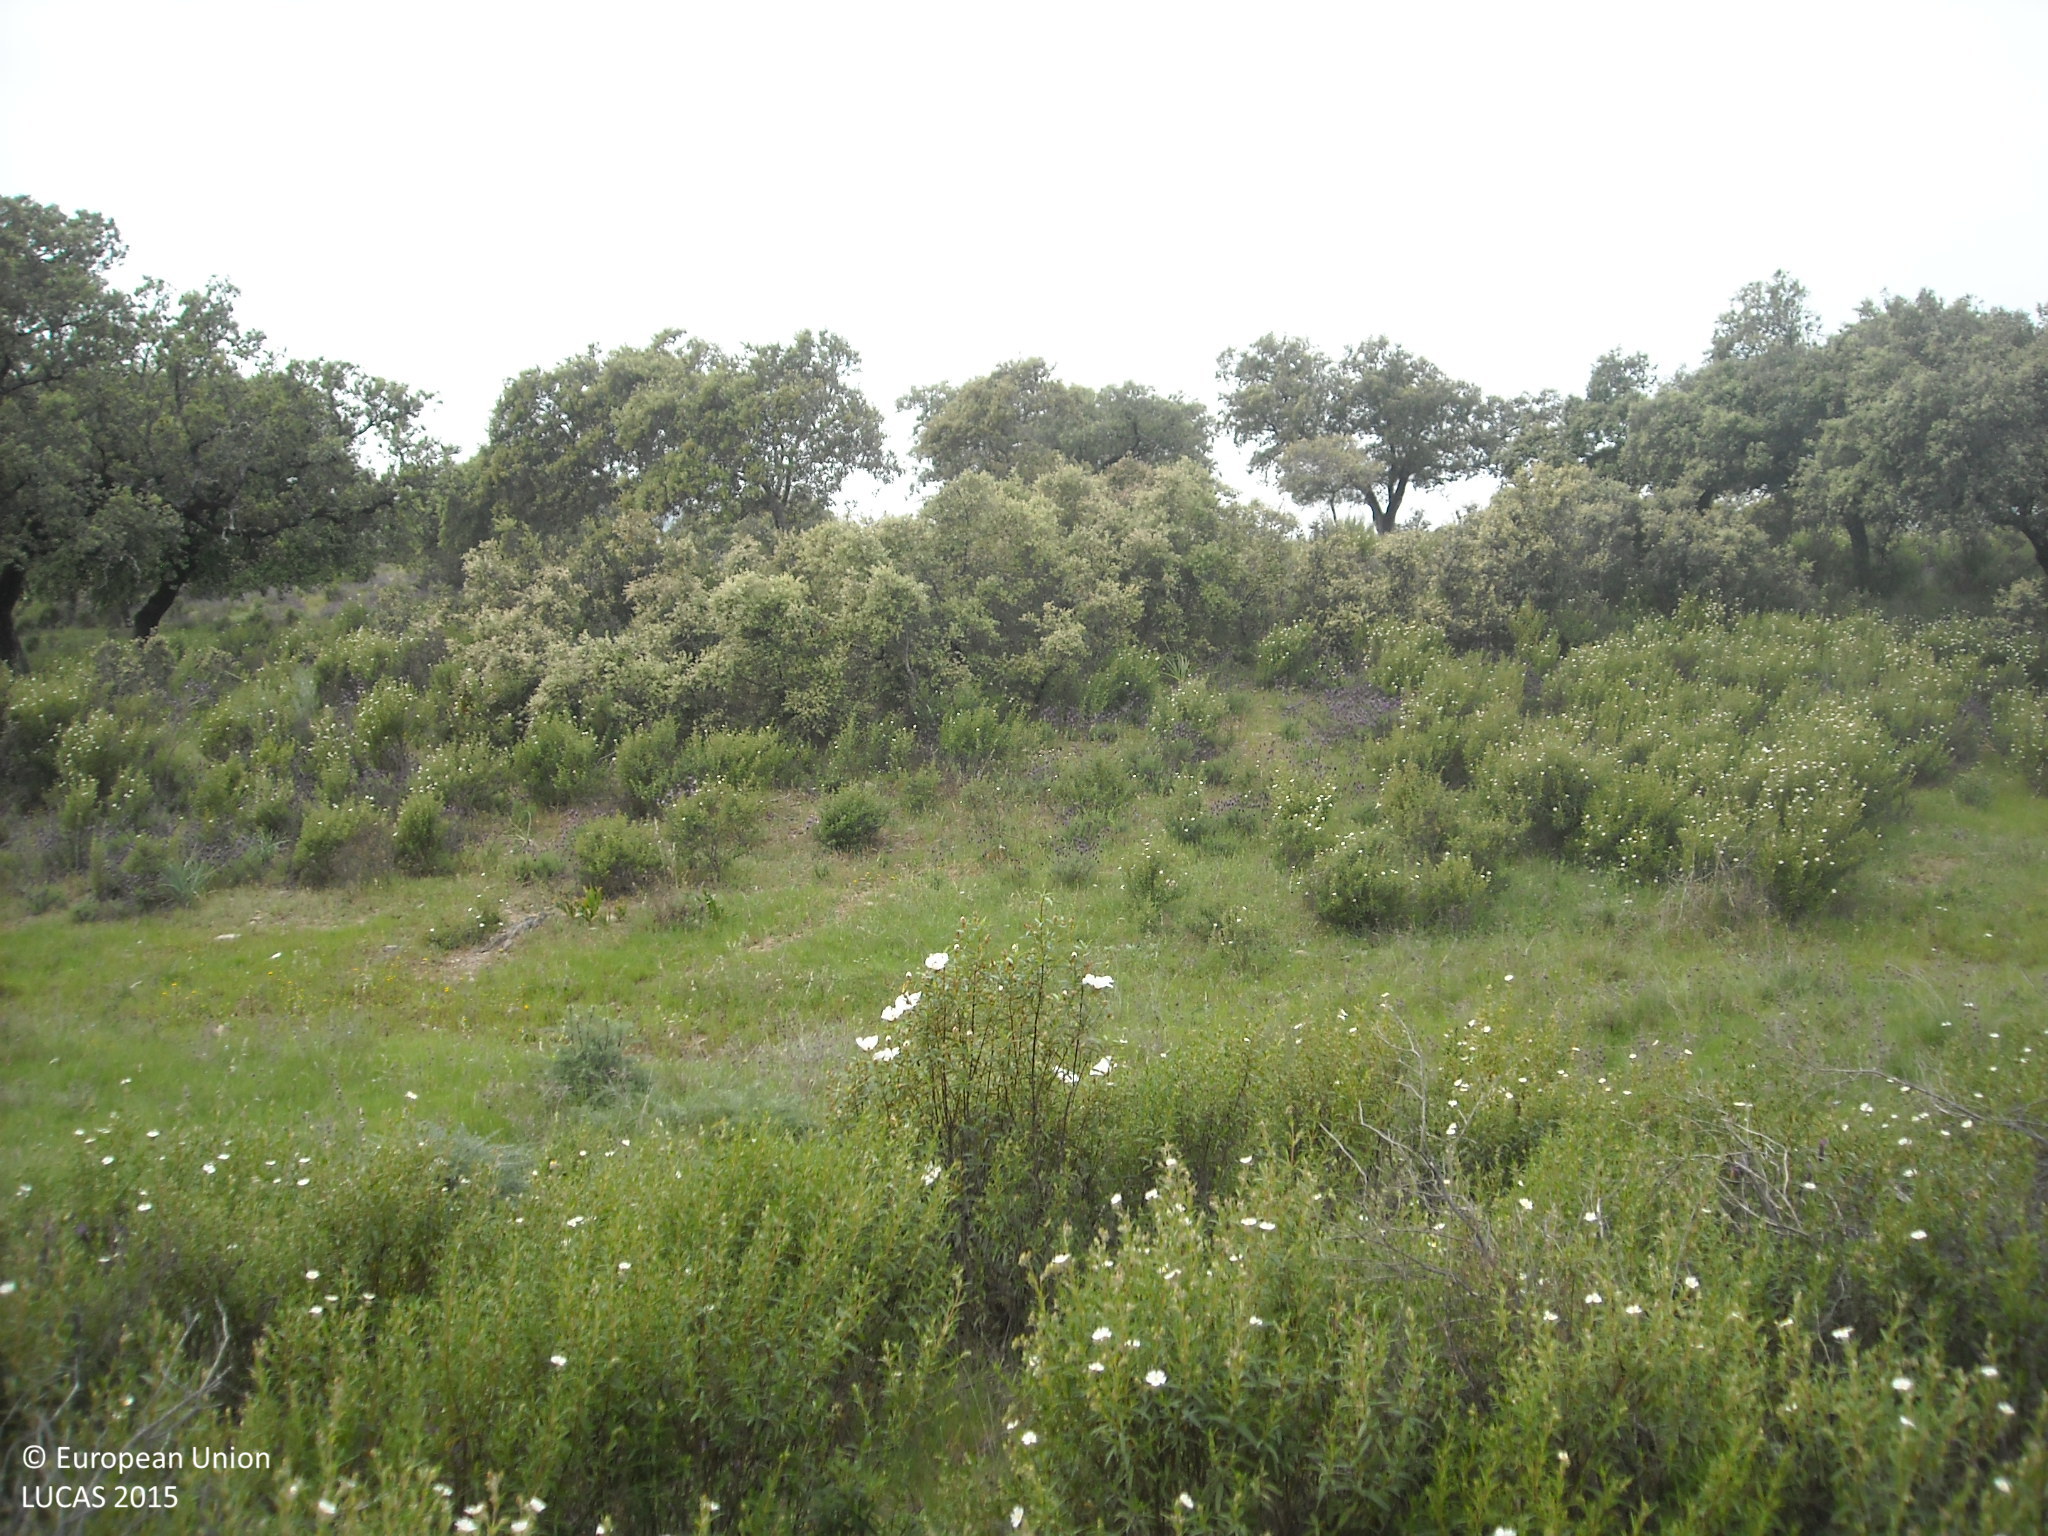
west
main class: Woodland
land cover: Broadleaved woodland
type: broadleaved evergreen forest
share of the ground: 10 - 25 %
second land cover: Shrubland without tree cover
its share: > 75 %
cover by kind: shrubs 75 %, broadleaved forest trees 20 %, herbaceous plants 5 %
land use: Forestry
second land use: Agriculture (excluding fallow land and kitchen gardens)
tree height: > 5 m
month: April
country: ES
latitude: 37.9182
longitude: -6.2942
